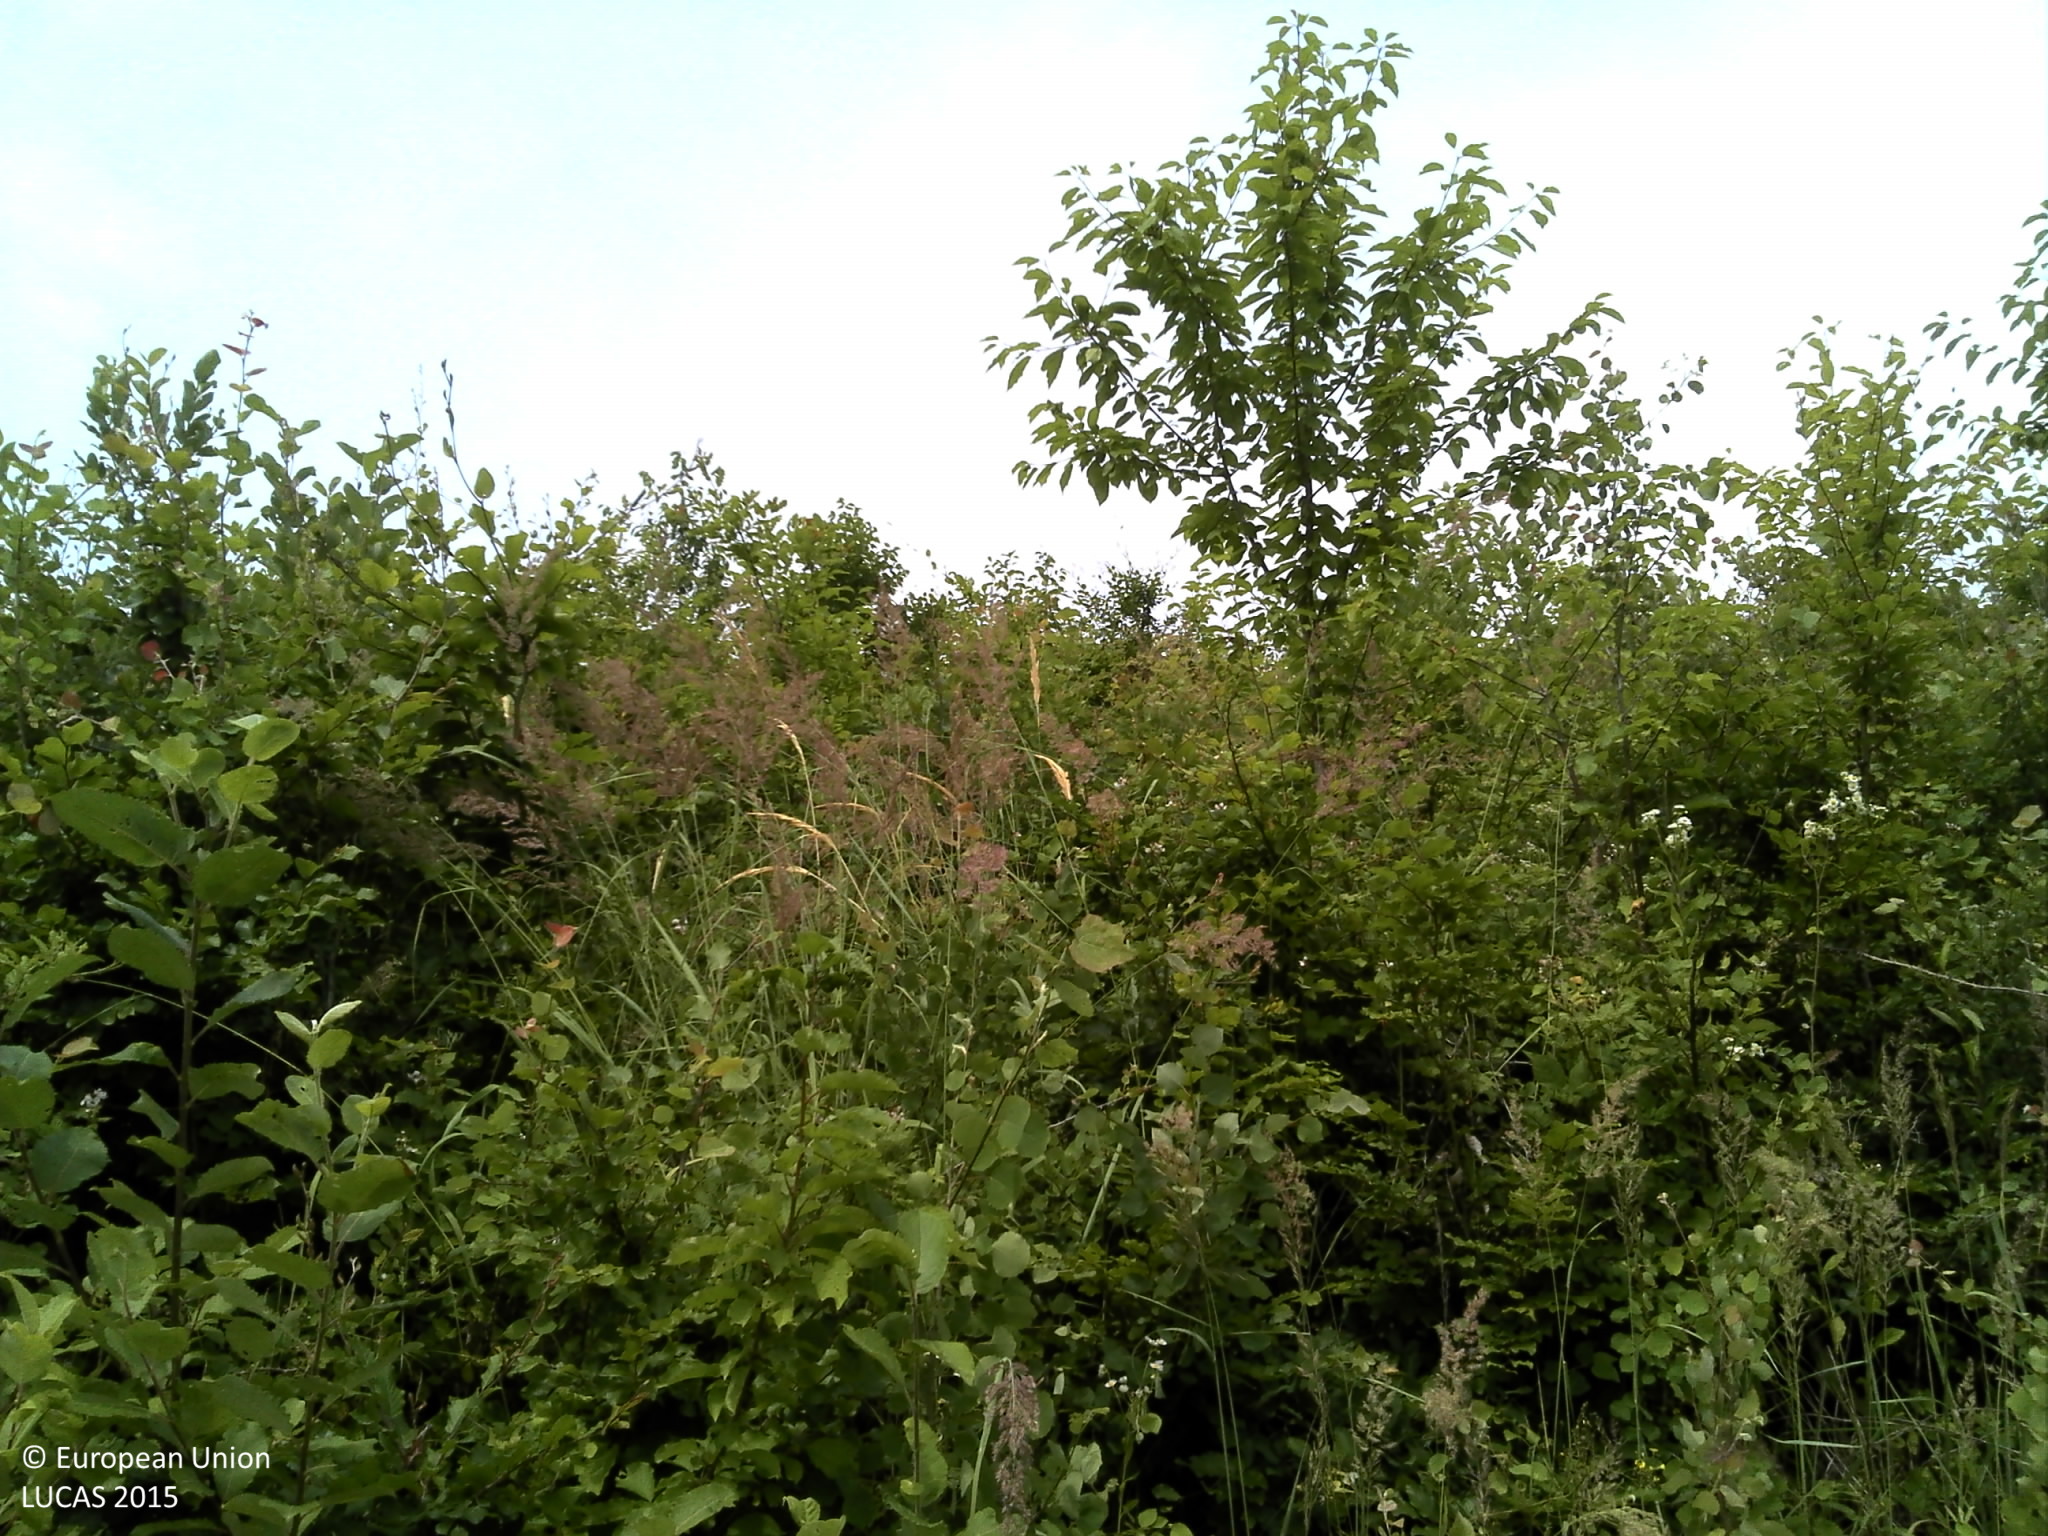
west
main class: Grassland
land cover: Spontaneously vegetated surfaces
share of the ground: > 75 %
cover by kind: herbaceous plants 90 %, shrubs 5 %, lichens and mosses 5 %
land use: Forestry
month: June
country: HR
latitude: 45.3358
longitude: 17.3889
